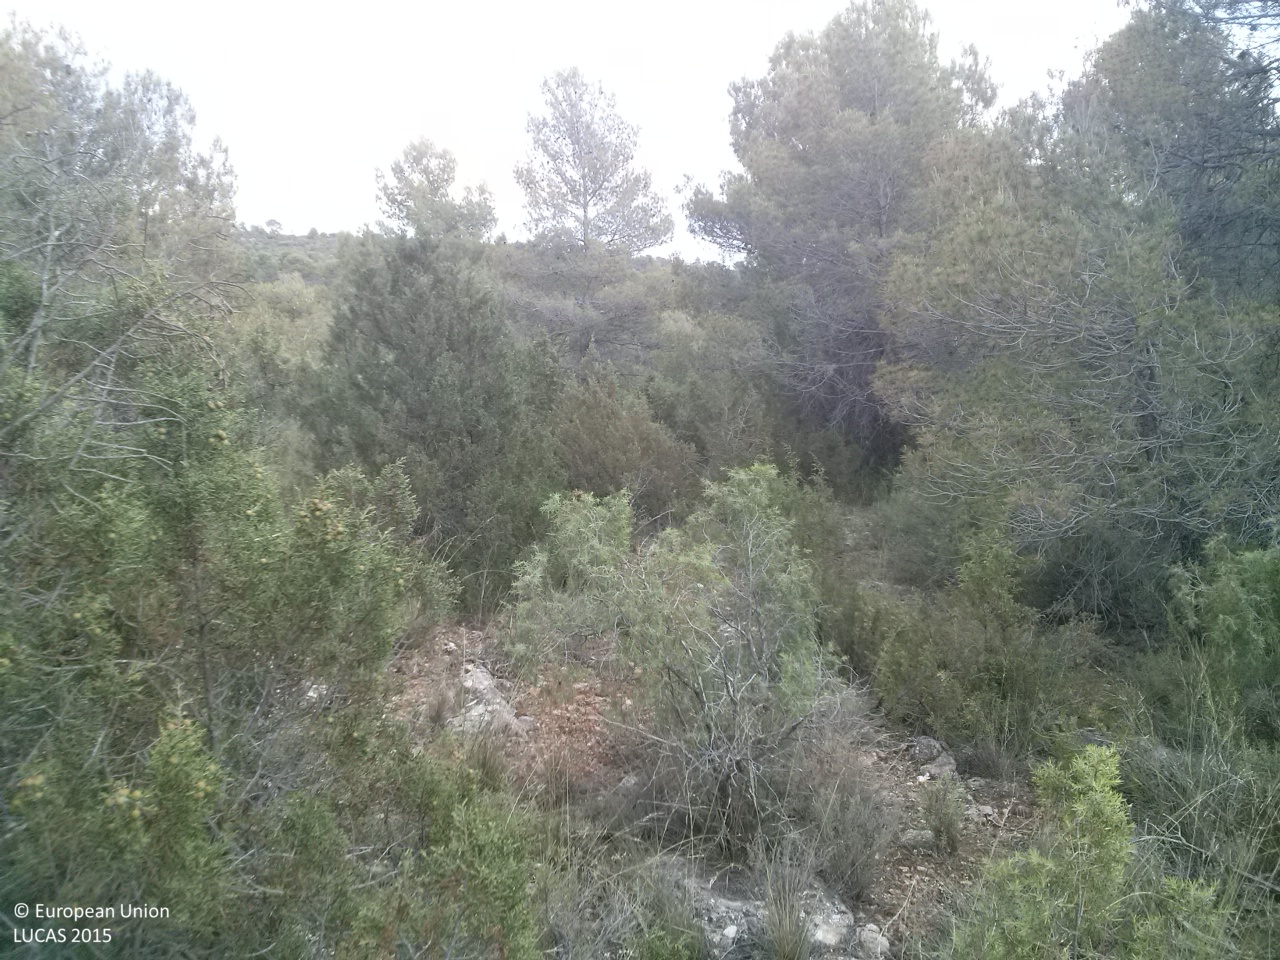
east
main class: Woodland
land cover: Pine dominated coniferous woodland
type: coniferous forest of the mediterranean region
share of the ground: 10 - 25 %
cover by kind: shrubs 50 %, coniferous forest trees 25 %, herbaceous plants 25 %
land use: Forestry
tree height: > 5 m
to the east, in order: Pine dominated coniferous woodland; Tracks; Pine dominated coniferous woodland; Other coniferous woodland
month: June
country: ES
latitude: 39.7580
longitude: -1.7629
